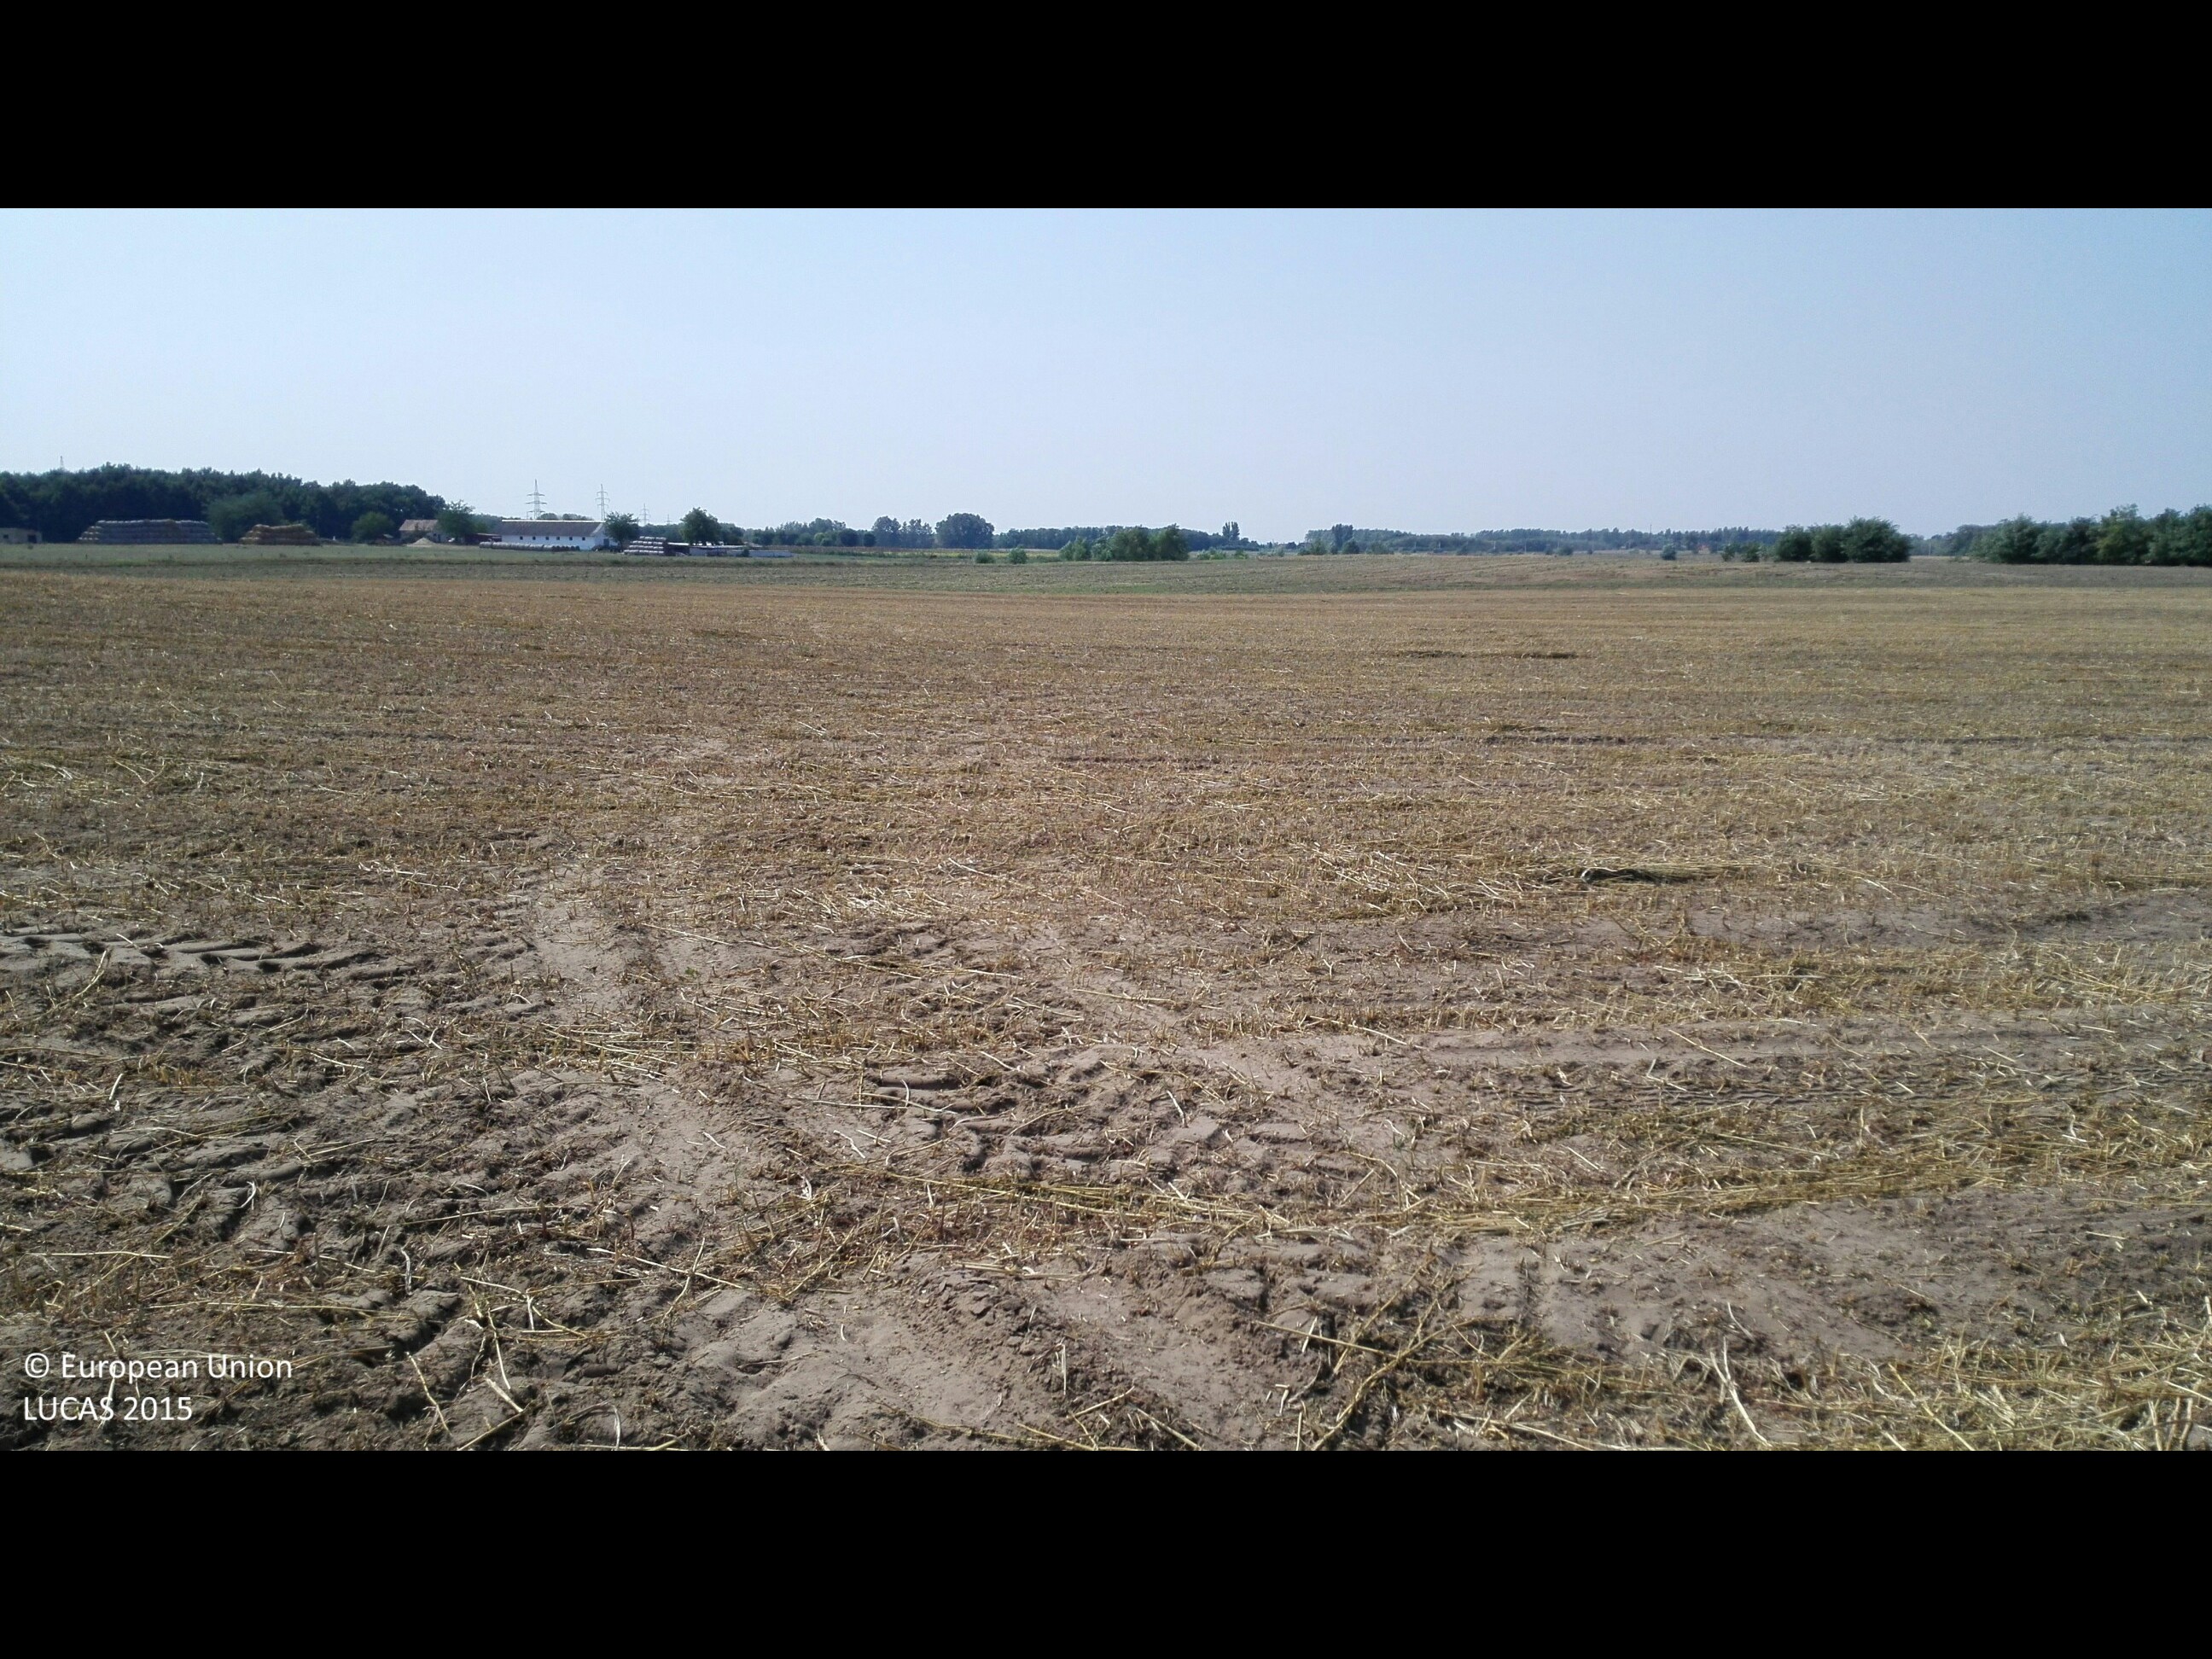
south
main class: Cropland
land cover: Rape and turnip rape
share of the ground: 10 - 25 %
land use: Agriculture (excluding fallow land and kitchen gardens)
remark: Harvested field
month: August
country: HU
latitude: 47.4757
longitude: 21.6552
